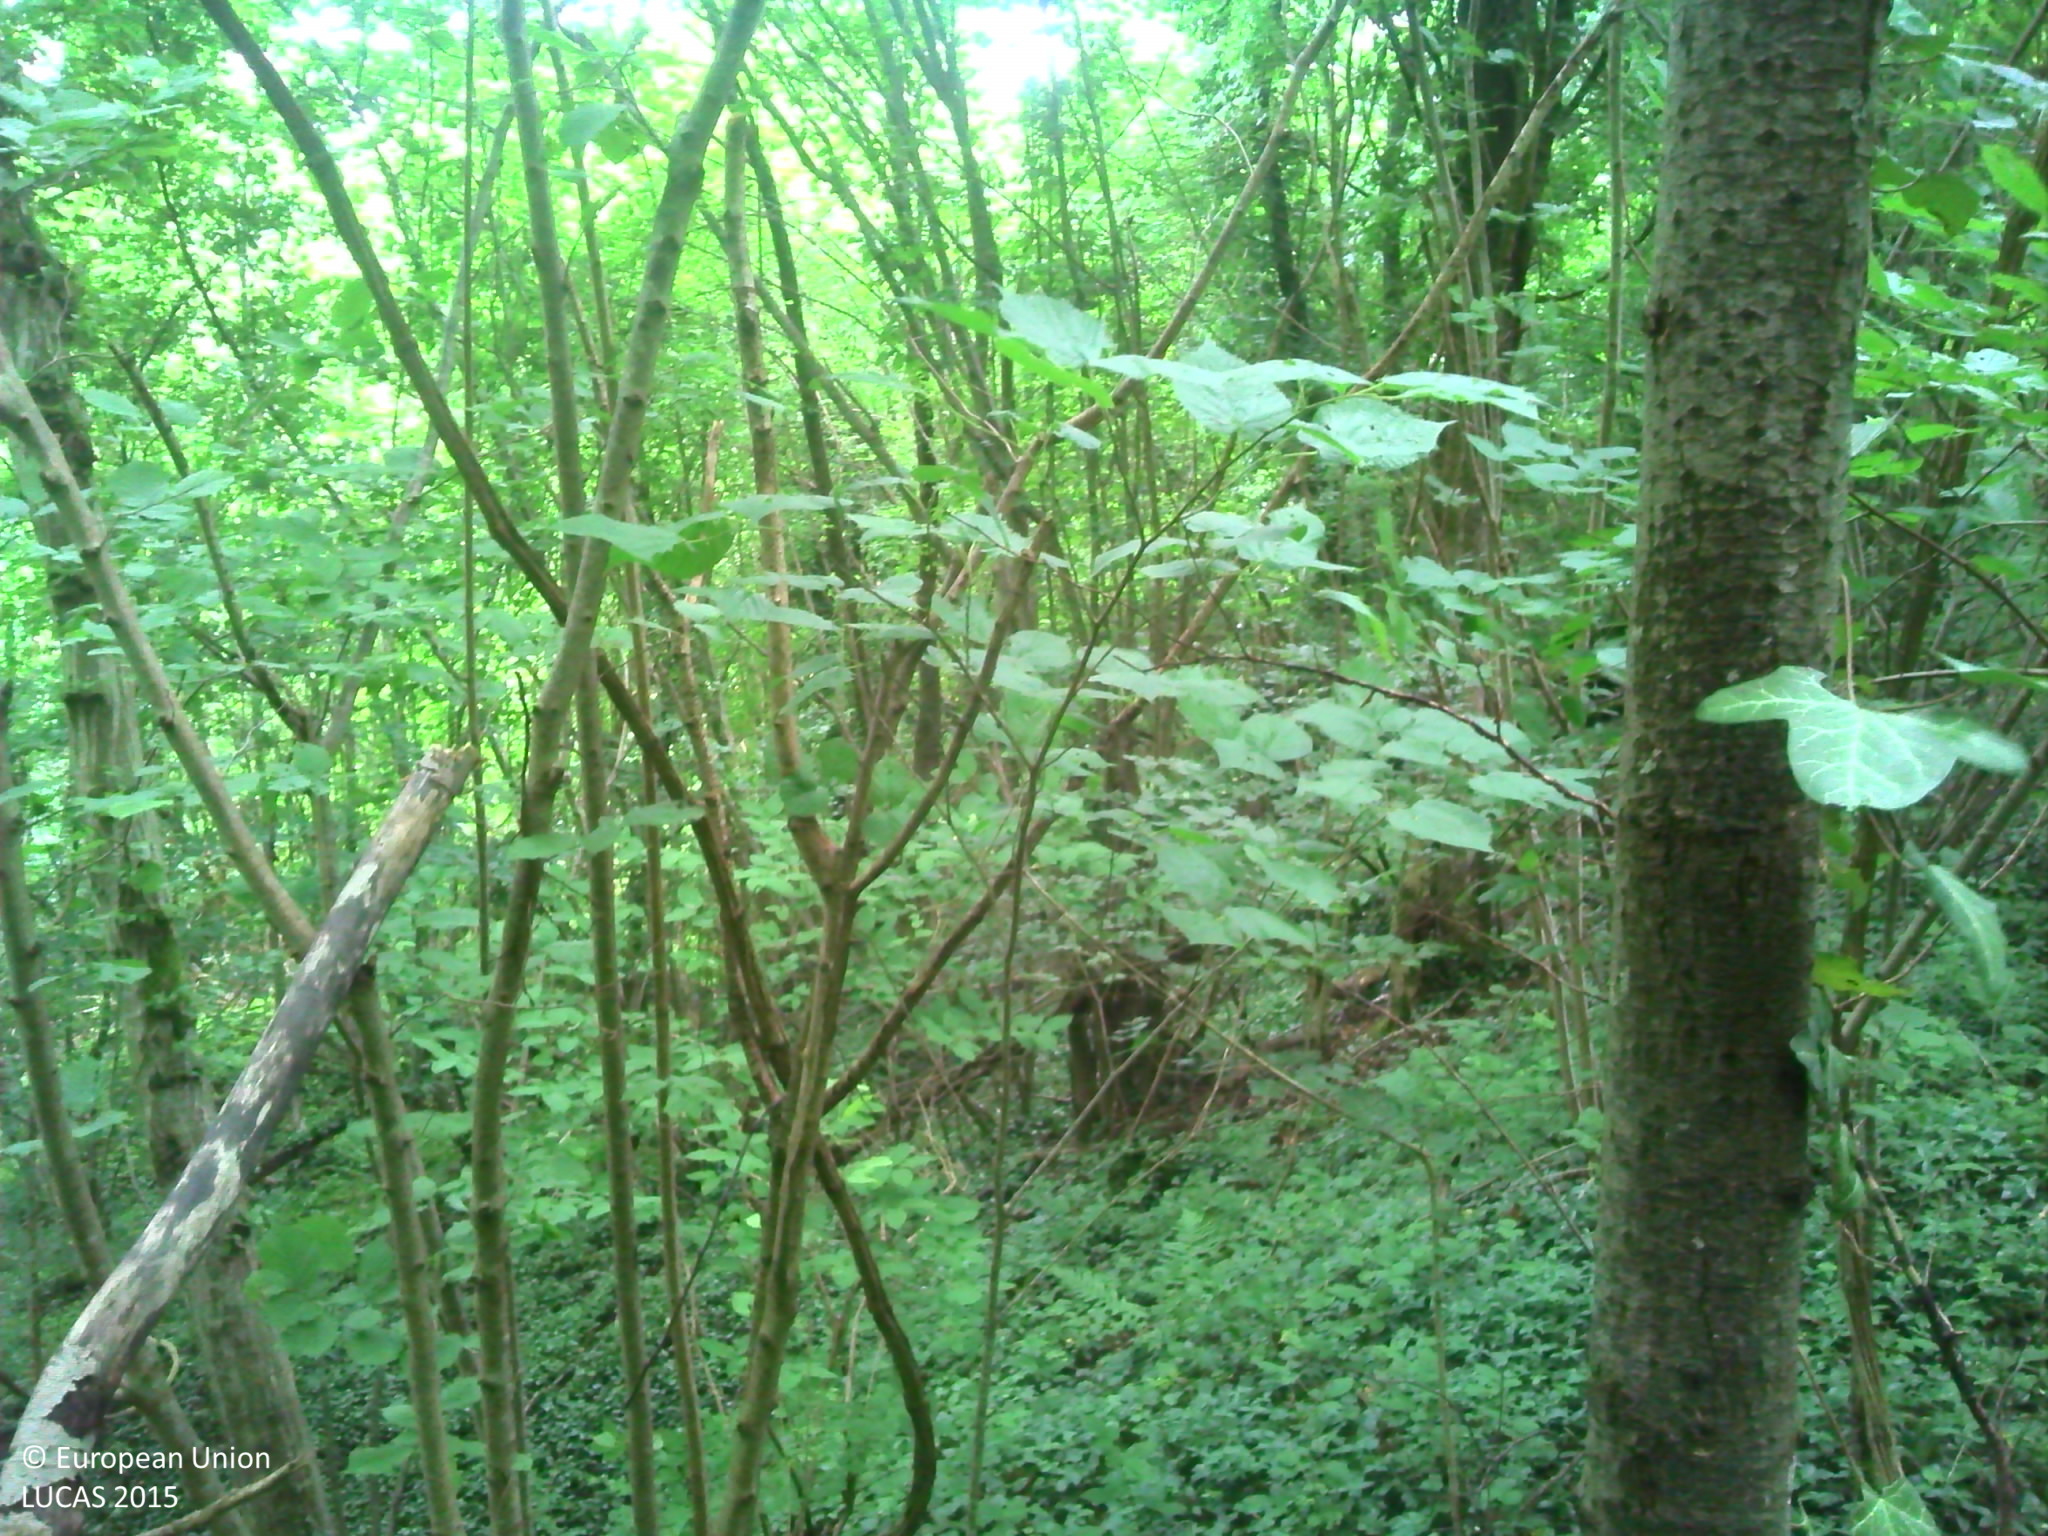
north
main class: Woodland
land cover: Broadleaved woodland
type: mesophytic deciduous forest
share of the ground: > 75 %
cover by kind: broadleaved forest trees 85 %, shrubs 10 %, herbaceous plants 5 %
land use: Forestry
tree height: > 5 m
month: June
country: FR
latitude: 49.5040
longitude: 3.6828
